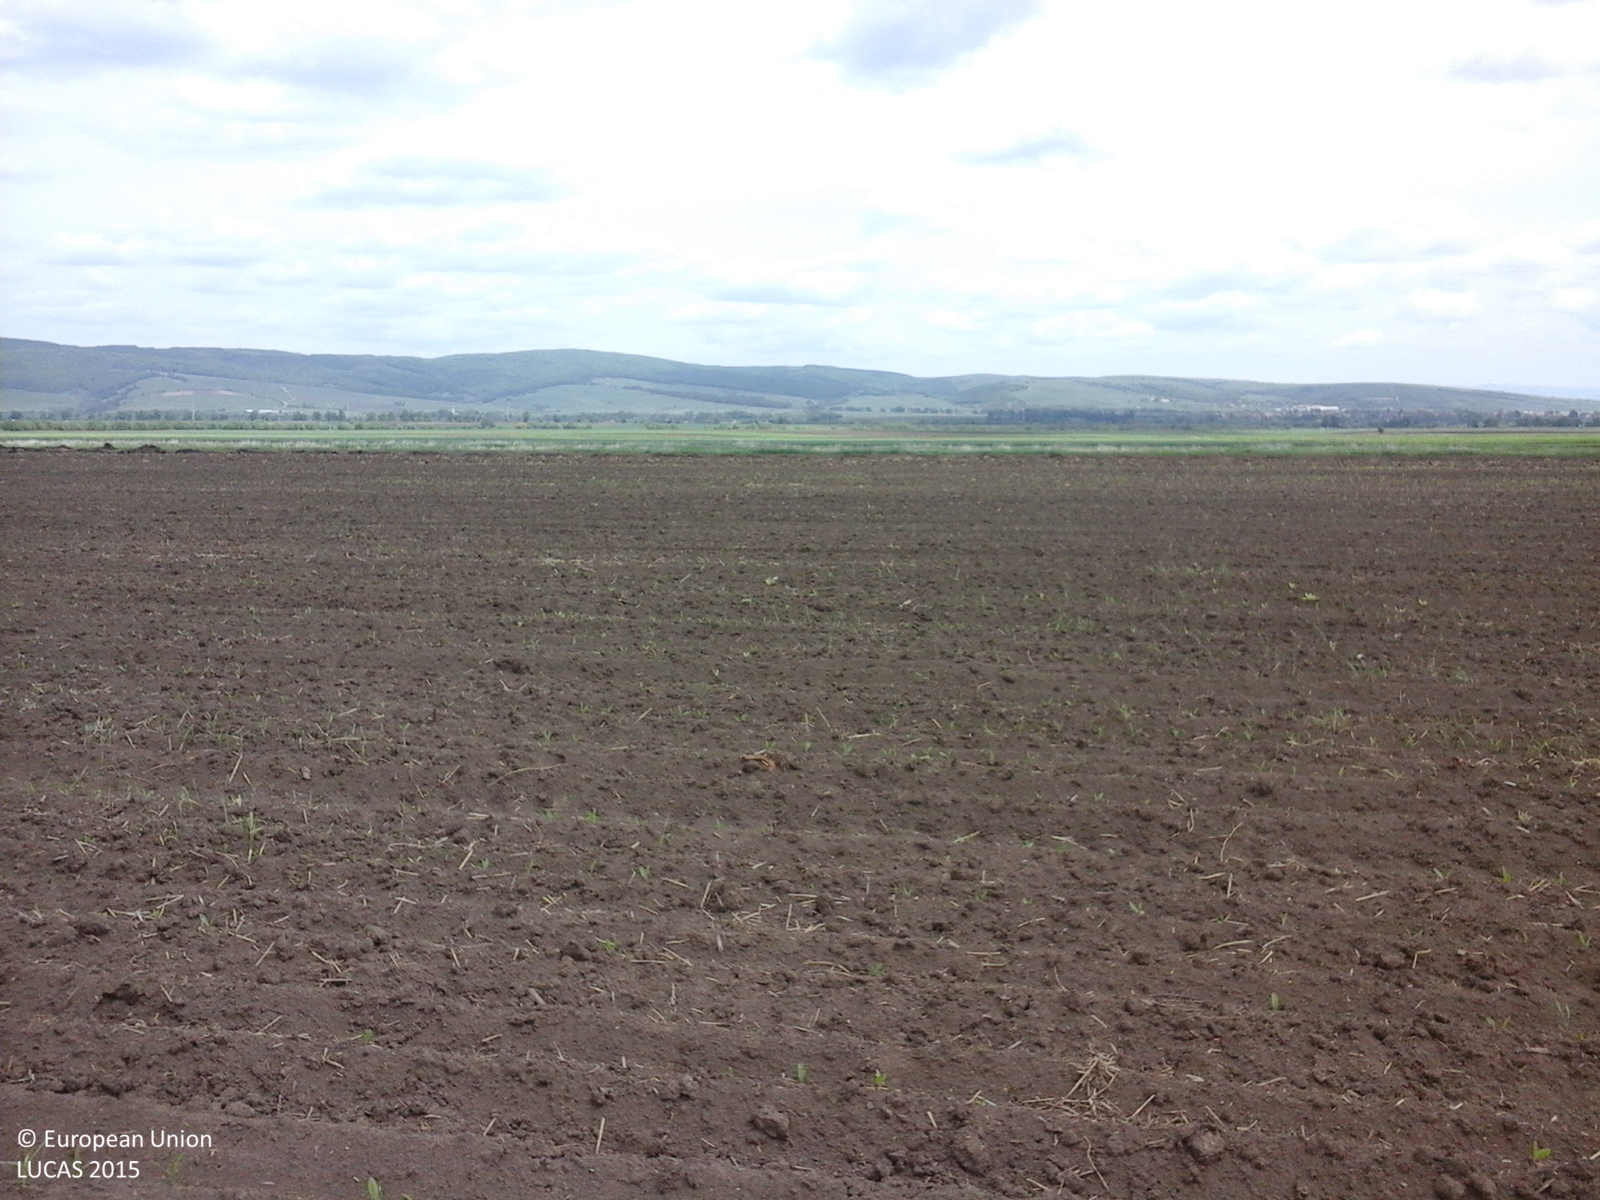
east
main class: Cropland
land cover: Maize
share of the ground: < 10 %
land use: Agriculture (excluding fallow land and kitchen gardens)
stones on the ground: < 10 %
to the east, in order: Maize; Potatoes; Sunflower; Grassland without tree/shrub cover; Maize; Common wheat
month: May
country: RO
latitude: 45.9190
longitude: 25.8031
